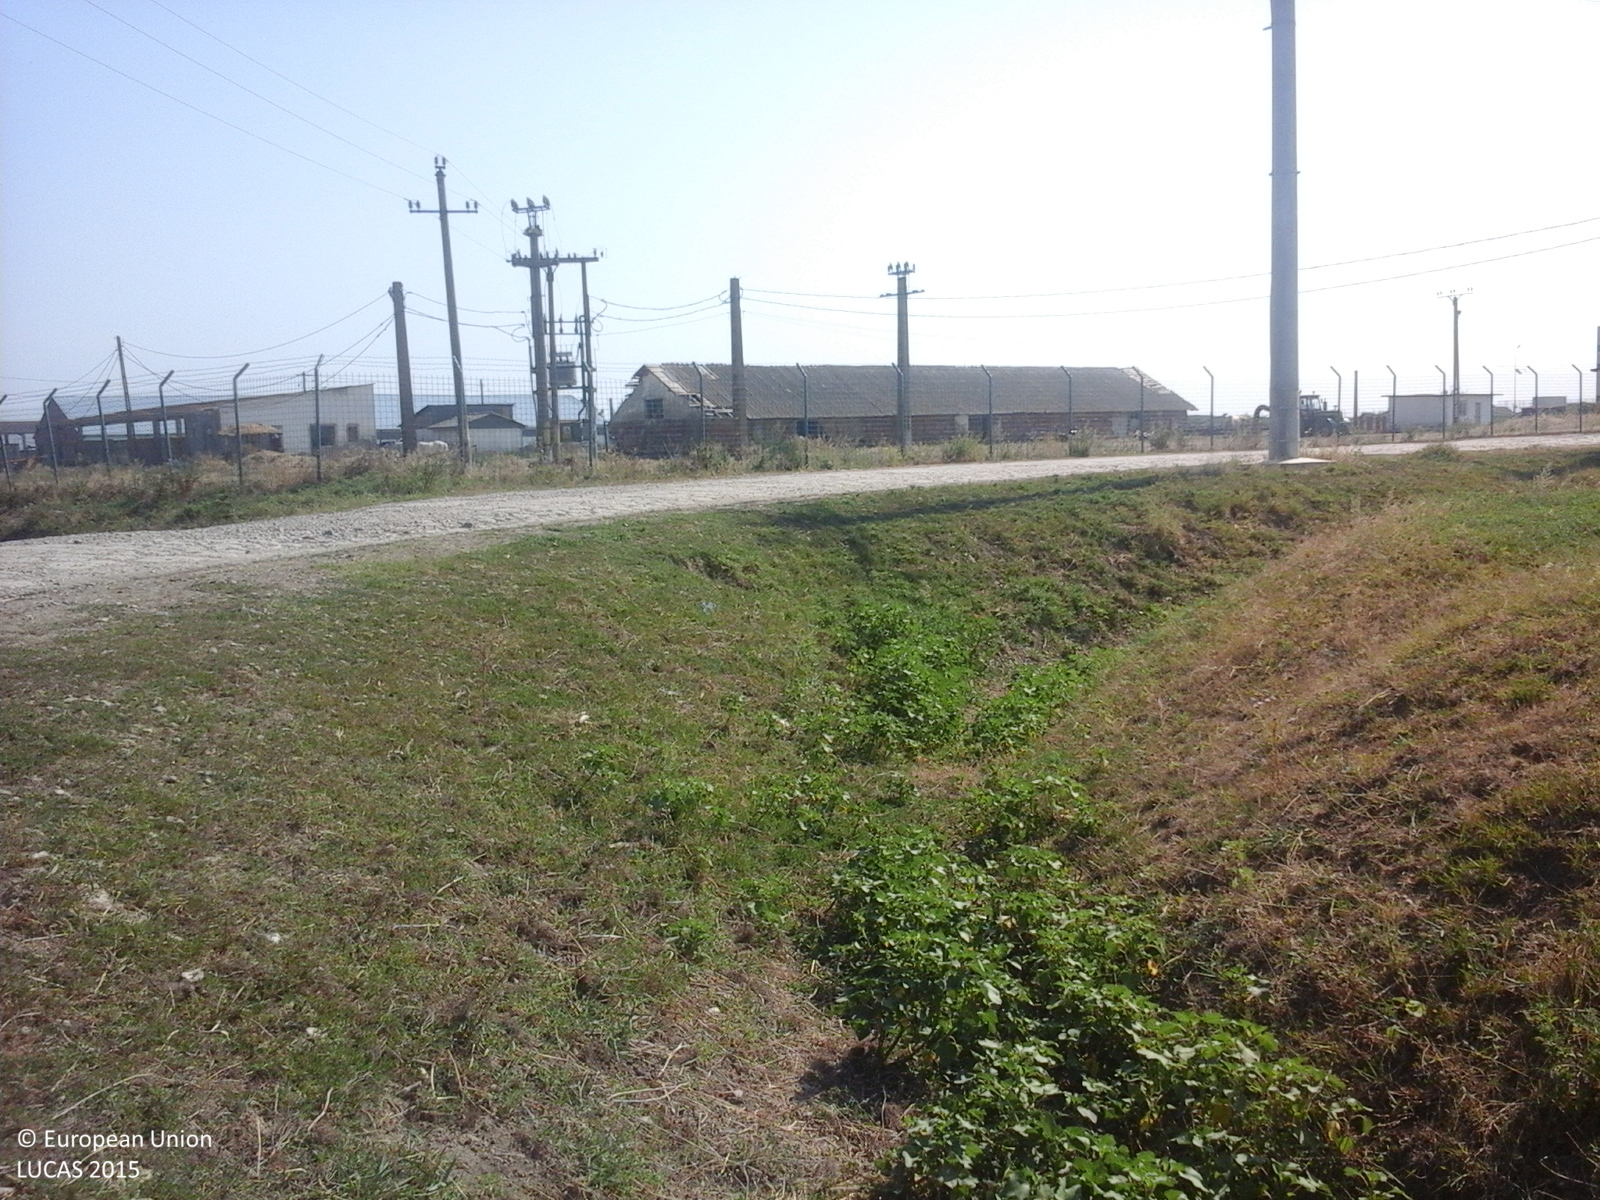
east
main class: Grassland
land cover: Grassland without tree/shrub cover
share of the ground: > 75 %
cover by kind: herbaceous plants 100 %
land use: Agriculture (excluding fallow land and kitchen gardens)
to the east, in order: Grassland without tree/shrub cover; Ditches and canals; Grassland without tree/shrub cover; Electric lines; Grass margins; Tracks; Grass margins; Fences; Grassland without tree/shrub cover; Artificial constructions in urban areas; Grassland without tree/shrub cover; Fences; Grassland without tree/shrub cover; Artificial constructions in urban areas
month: August
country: RO
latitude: 45.3644
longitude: 27.7659
